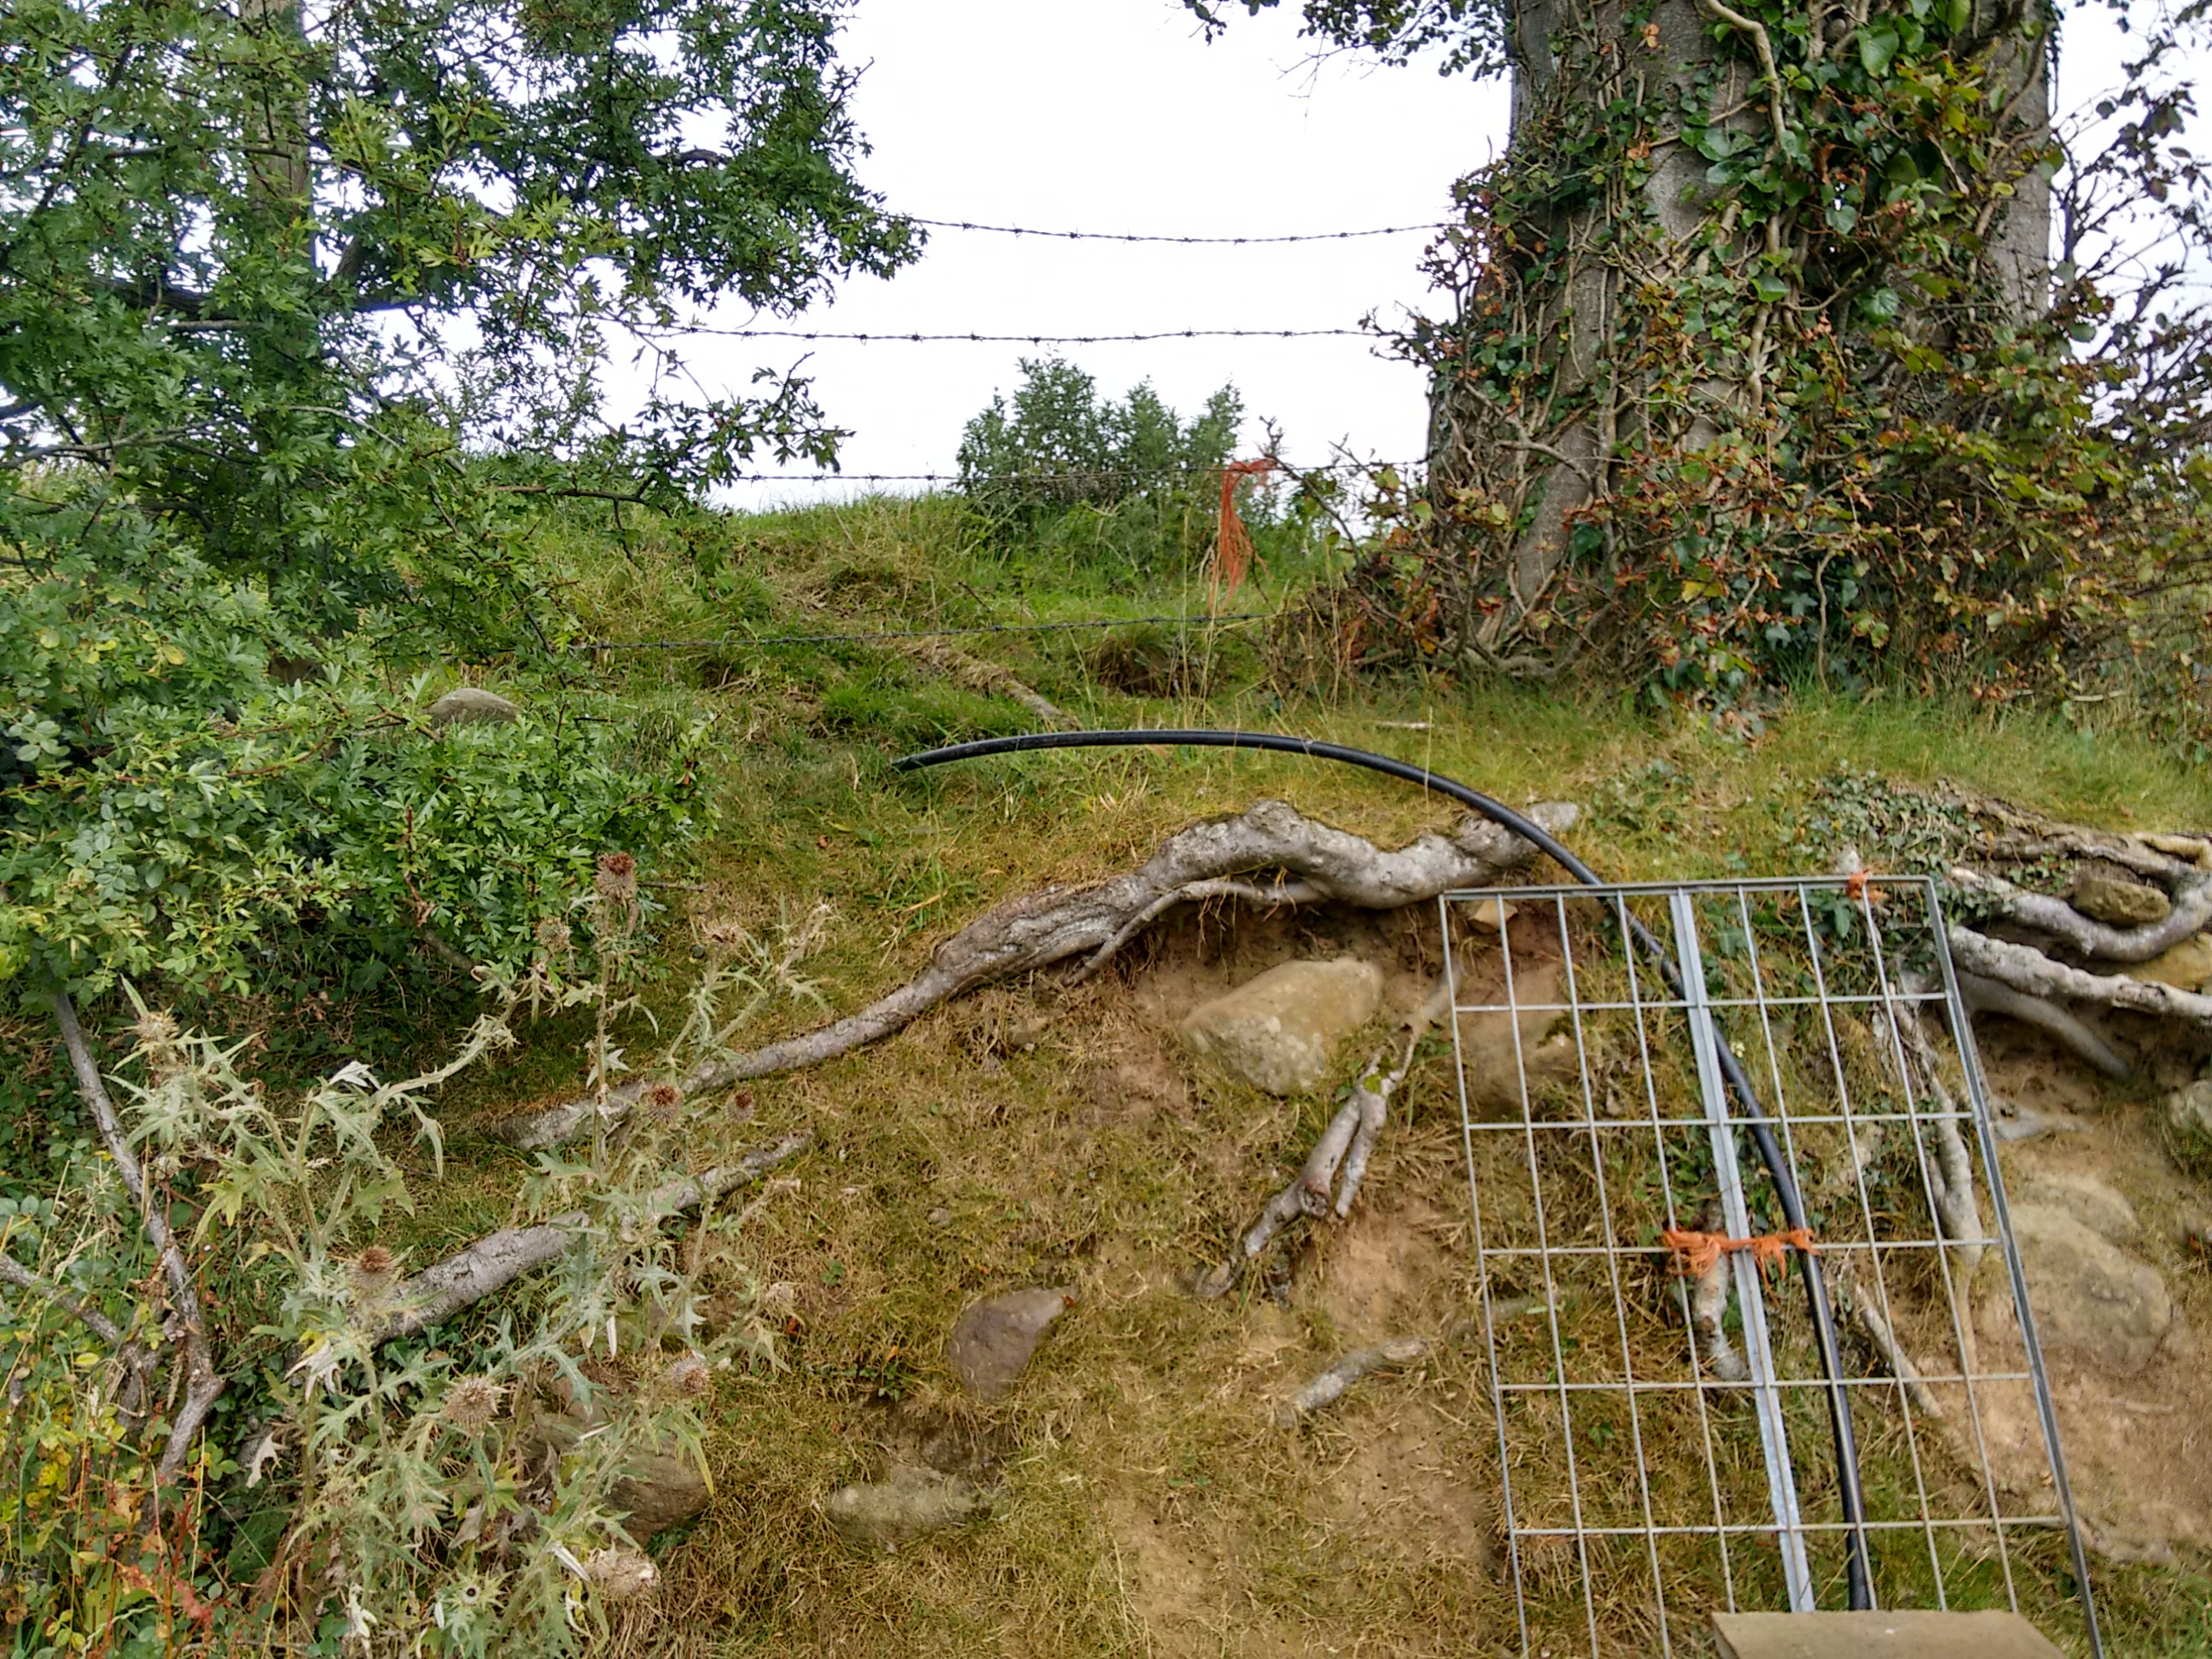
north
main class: Grassland
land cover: Grassland without tree/shrub cover
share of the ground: > 75 %
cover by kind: herbaceous plants 100 %
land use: Agriculture (excluding fallow land and kitchen gardens)
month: August
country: GB
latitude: 54.3901
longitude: -6.9077
